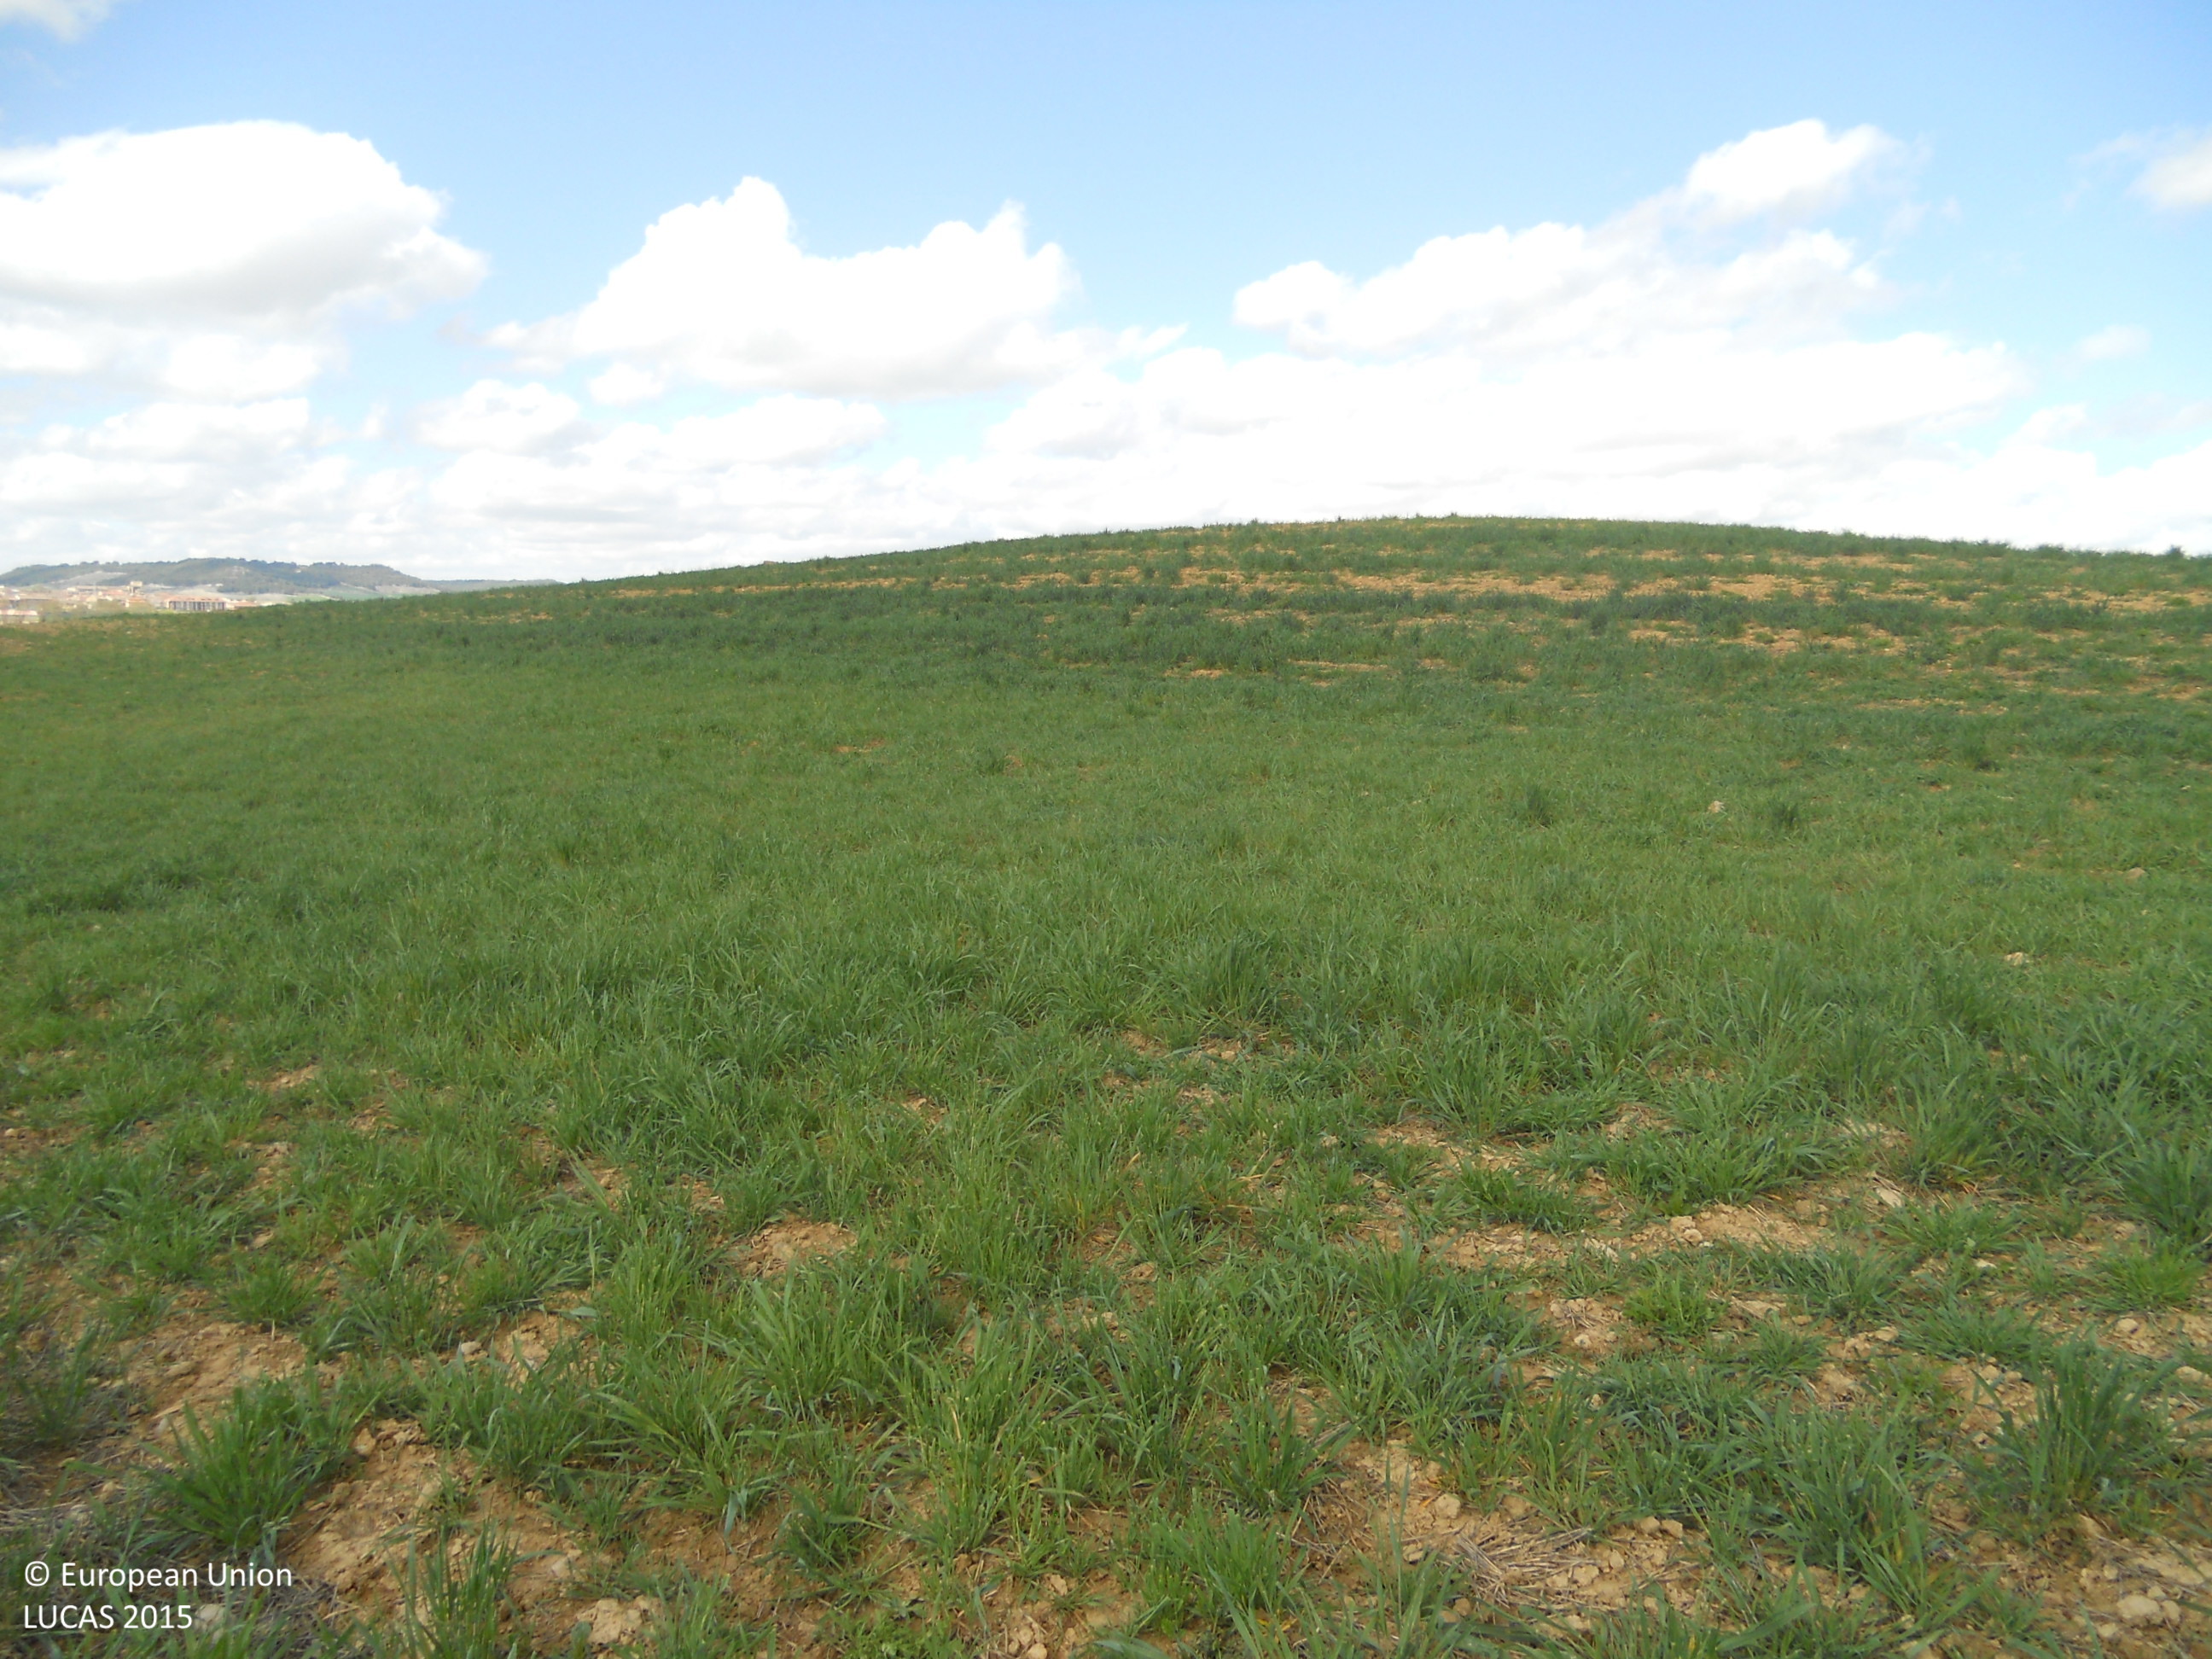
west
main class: Grassland
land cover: Spontaneously vegetated surfaces
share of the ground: 10 - 25 %
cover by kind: herbaceous plants 100 %
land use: Fallow land
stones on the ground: < 10 %
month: April
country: ES
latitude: 42.2046
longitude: -4.2751
